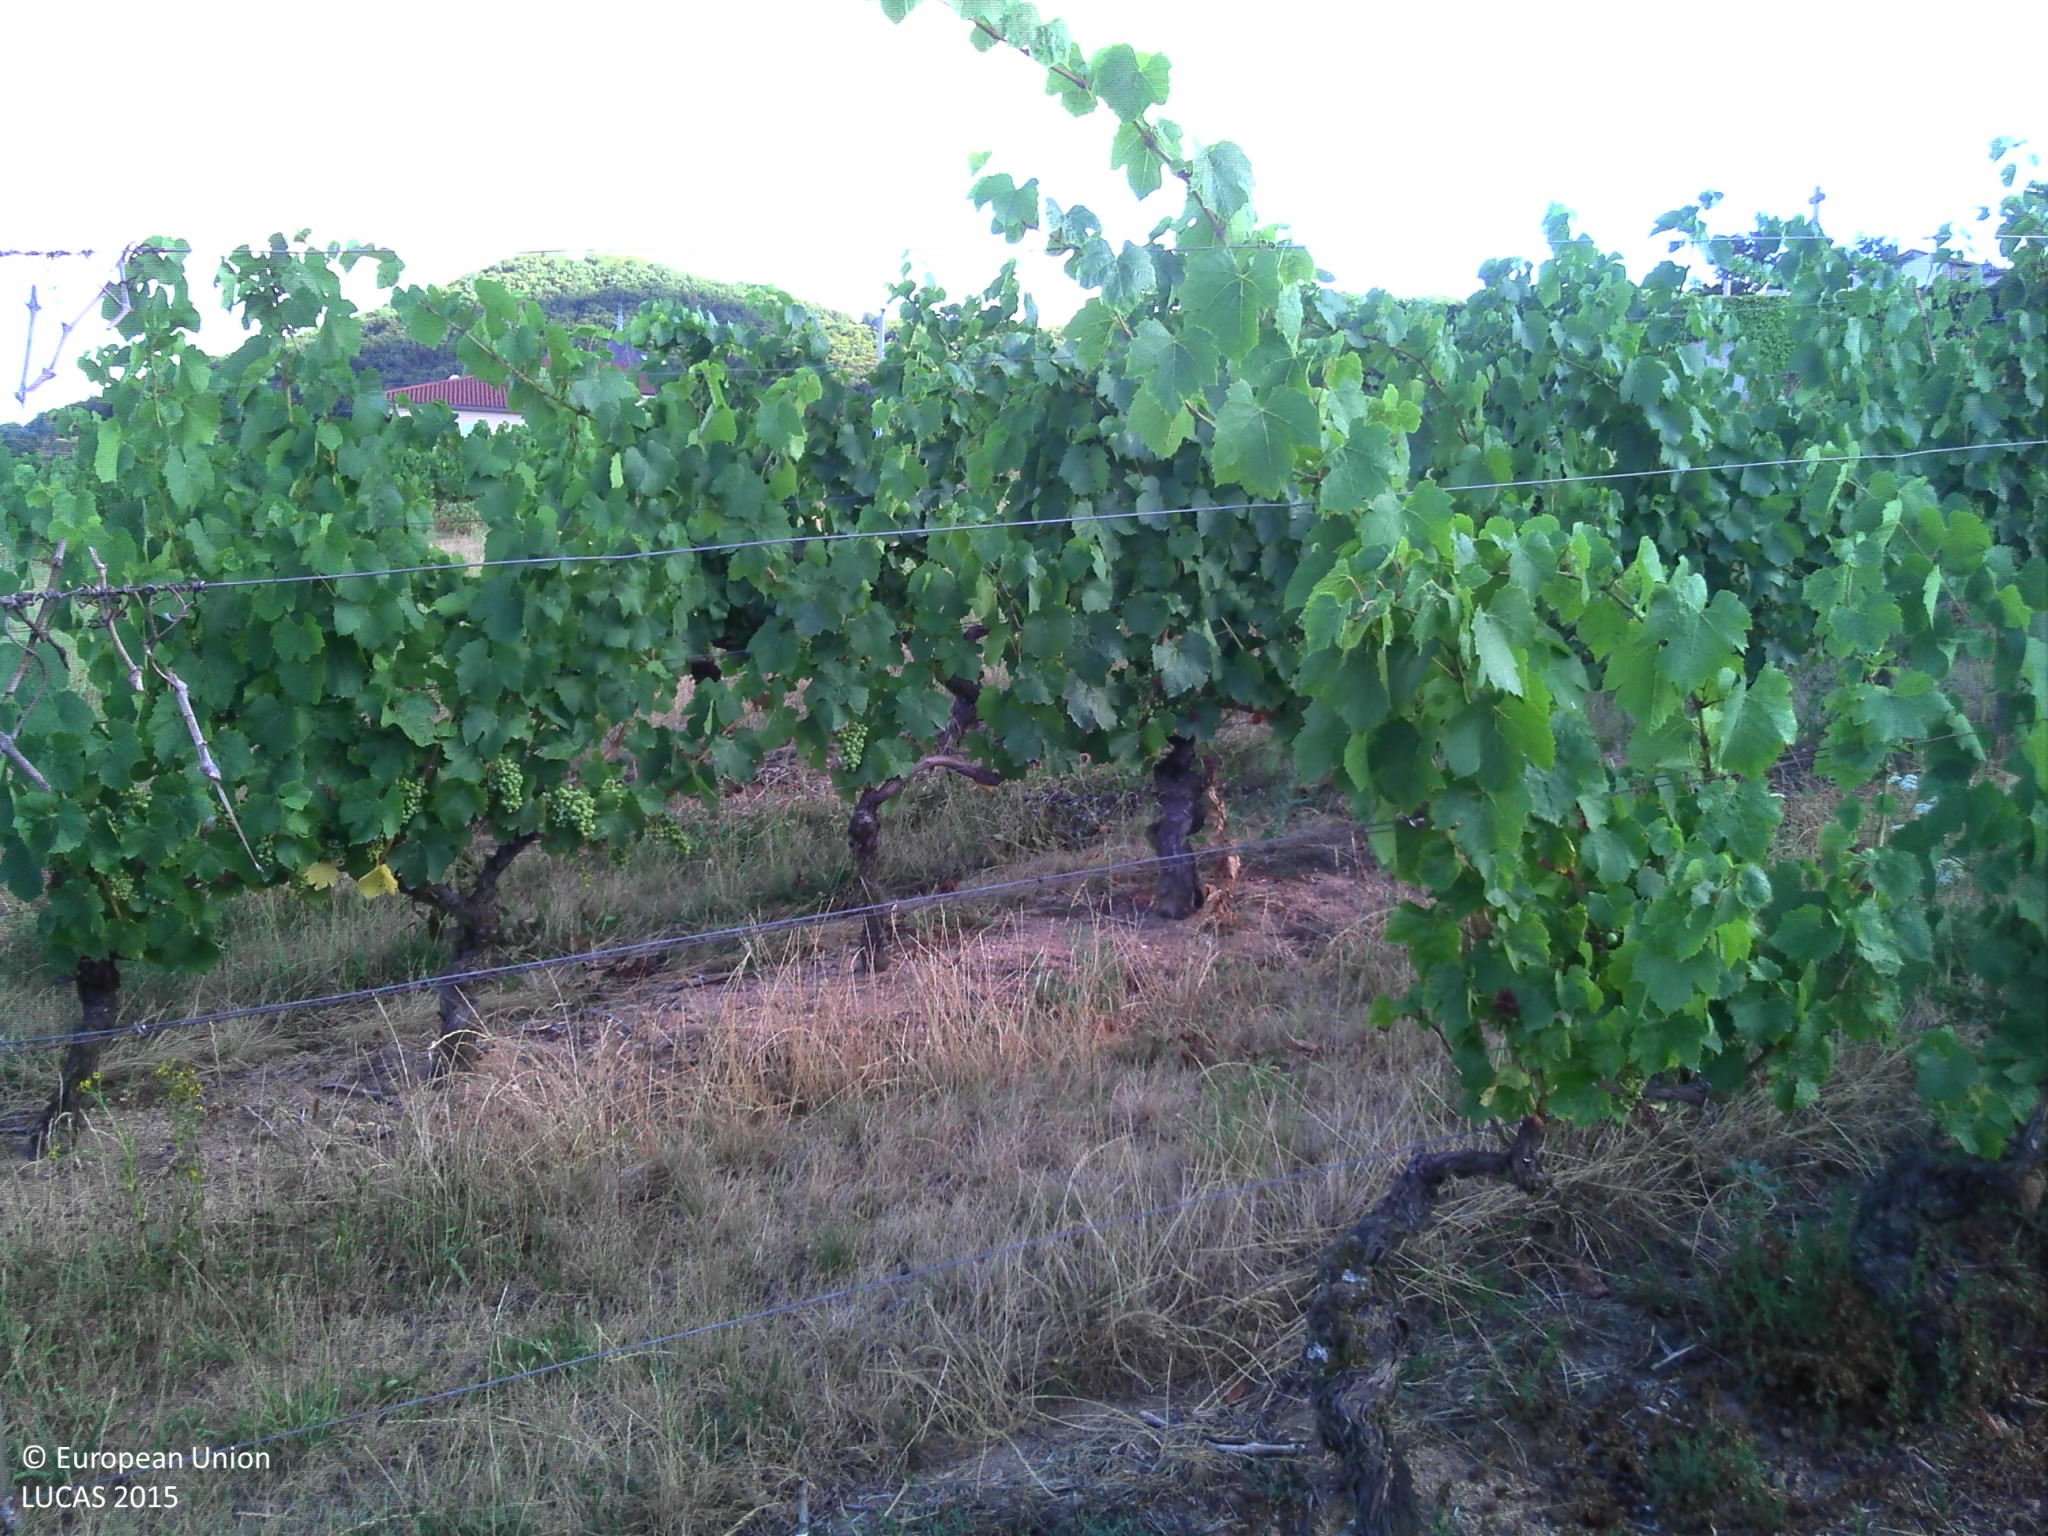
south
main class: Cropland
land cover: Vineyards
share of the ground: > 75 %
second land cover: Grassland without tree/shrub cover
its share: 10 - 25 %
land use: Agriculture (excluding fallow land and kitchen gardens)
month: July
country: FR
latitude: 45.8502
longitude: 4.5299
